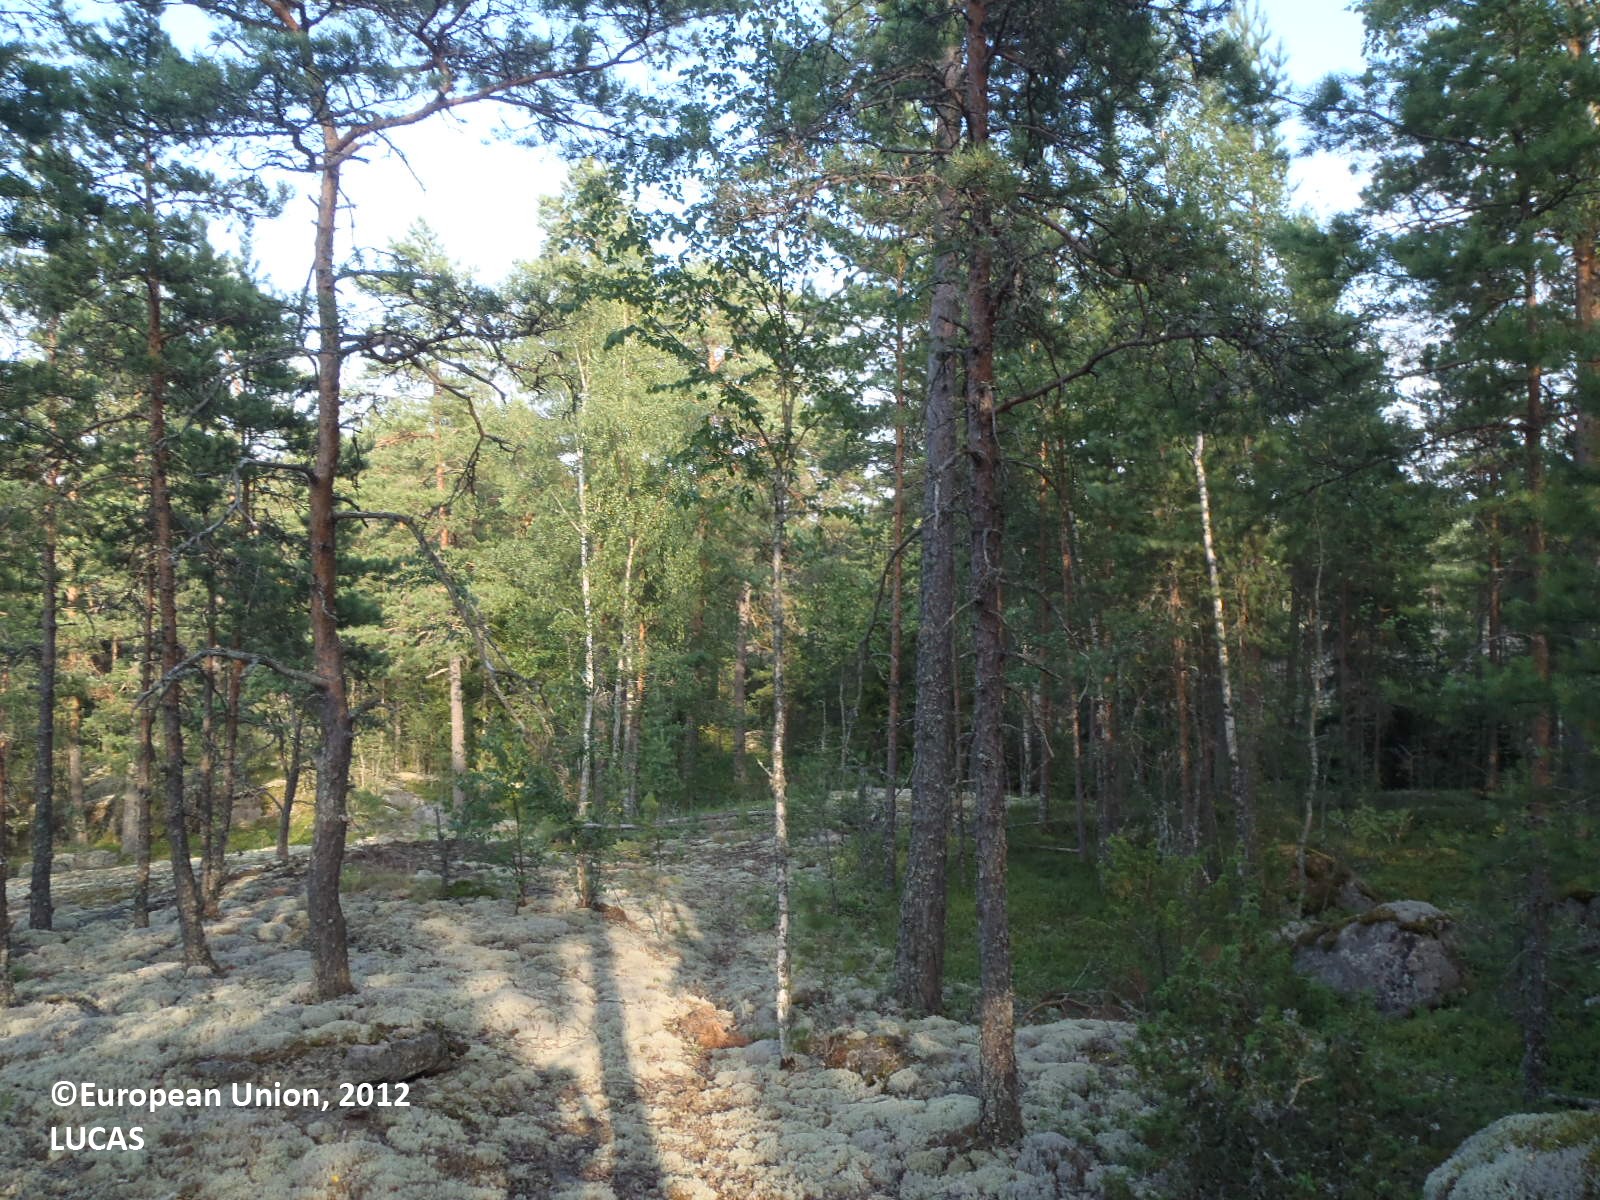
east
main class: Woodland
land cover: Pine dominated coniferous woodland
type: boreal forest
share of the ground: 50 - 75 %
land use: Semi-natural and natural areas not in use
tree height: > 5 m
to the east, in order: Pine dominated coniferous woodland
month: July
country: FI
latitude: 60.5509
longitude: 21.6737
